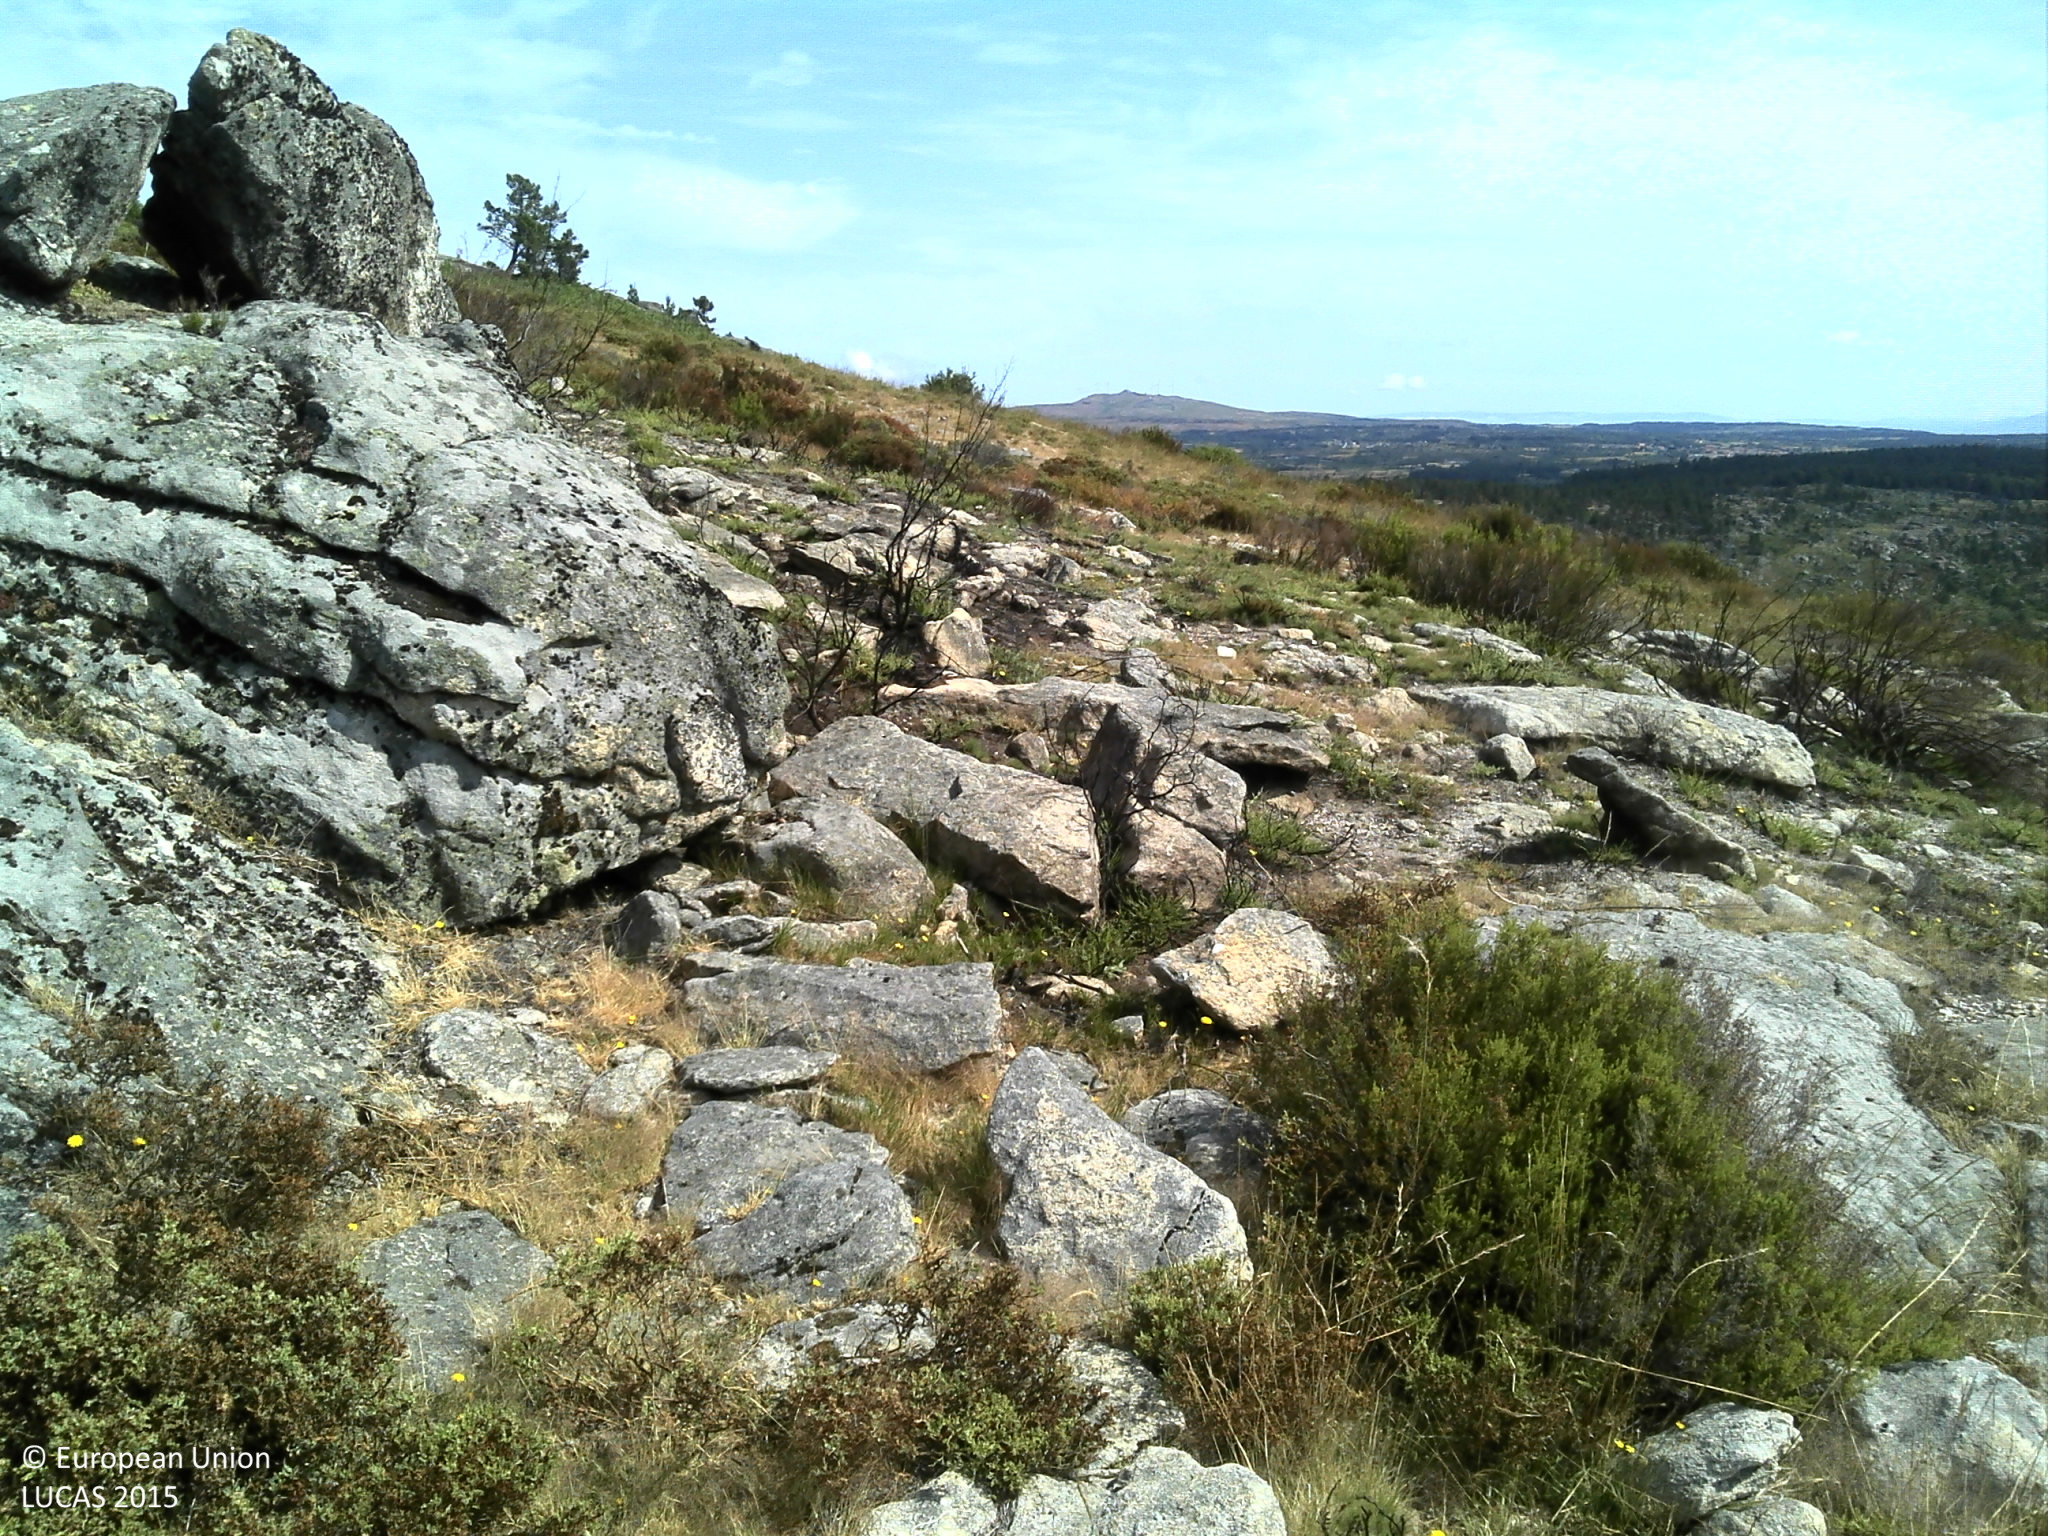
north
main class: Shrubland
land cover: Shrubland without tree cover
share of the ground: 50 - 75 %
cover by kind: shrubs 60 %, consolidated bare surface 30 %, unconsolidated bare surface 10 %
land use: Agriculture (excluding fallow land and kitchen gardens)
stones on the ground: 25 - 50 %
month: July
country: PT
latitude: 41.4466
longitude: -7.7155
